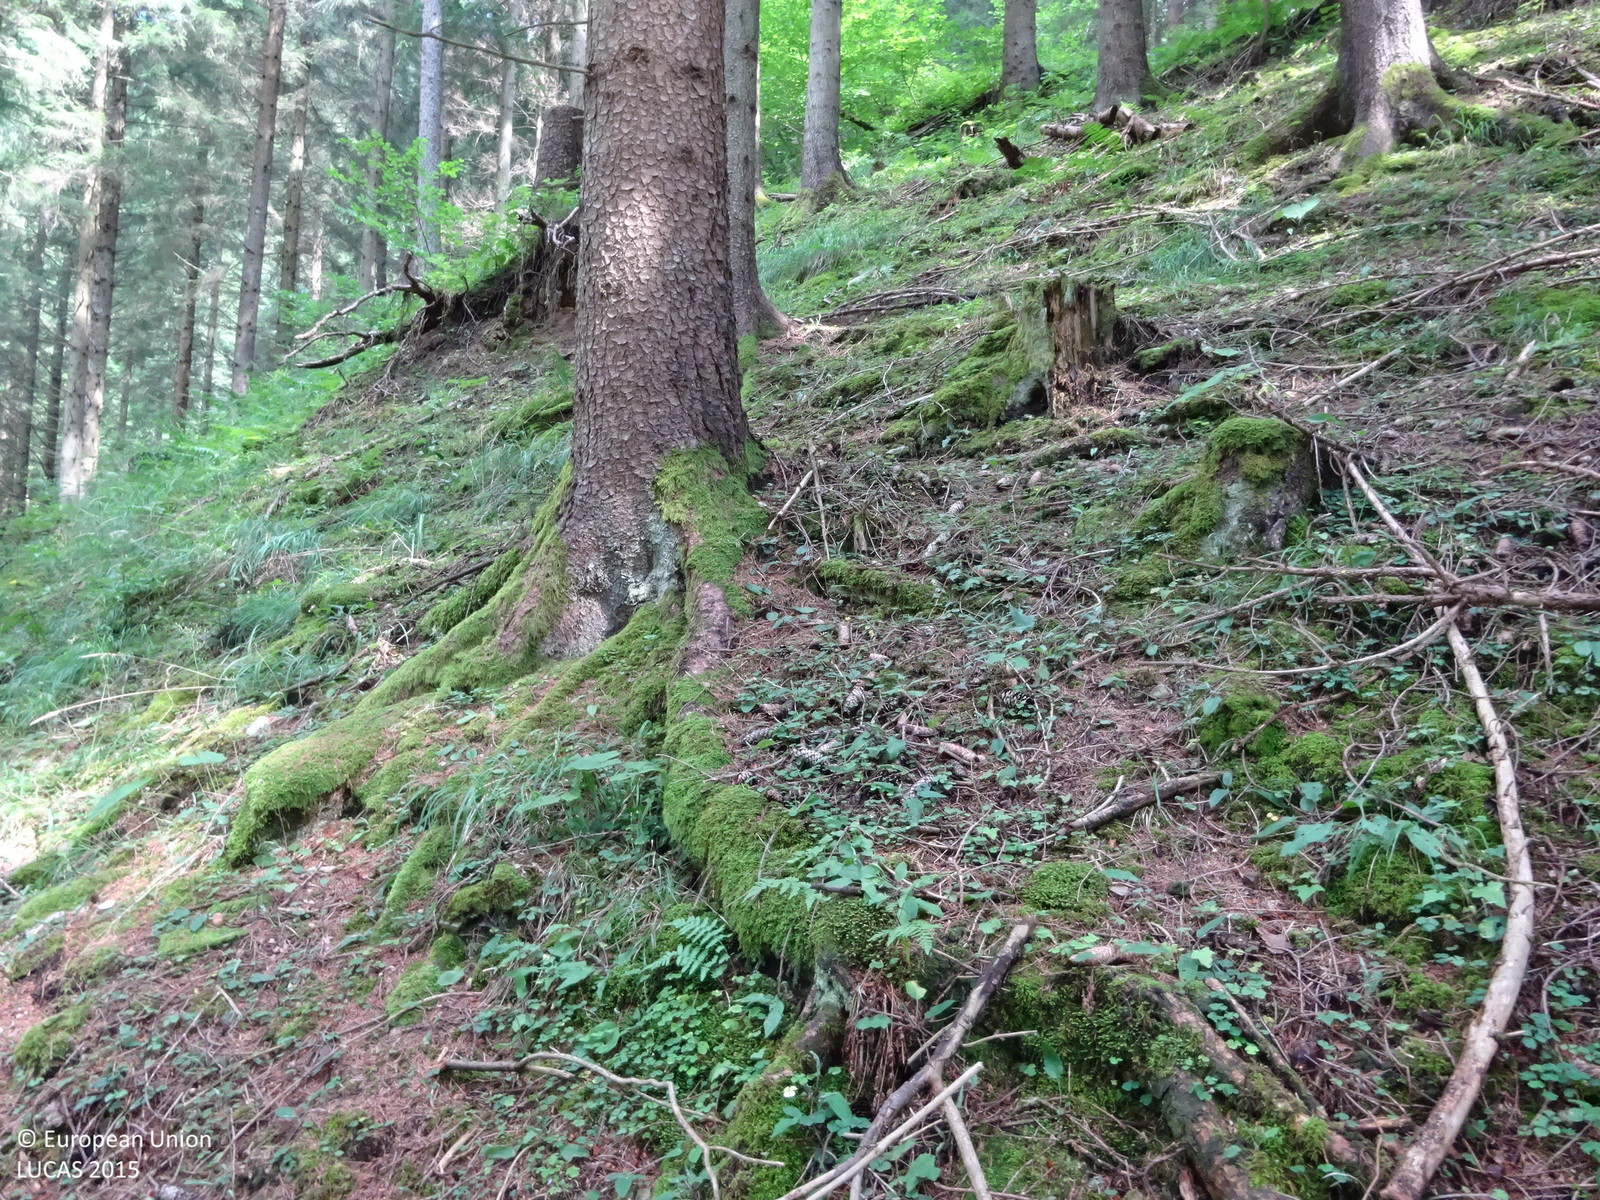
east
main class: Woodland
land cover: Spruce dominated coniferous woodland
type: alpine coniferous forest
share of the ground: > 75 %
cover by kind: coniferous forest trees 100 %
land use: Forestry
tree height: > 5 m
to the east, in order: Spruce dominated coniferous woodland; Tracks; Spruce dominated coniferous woodland; Tracks; Spruce dominated coniferous woodland; Tracks; Spruce dominated coniferous woodland
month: July
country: AT
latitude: 47.3829
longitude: 15.4977
